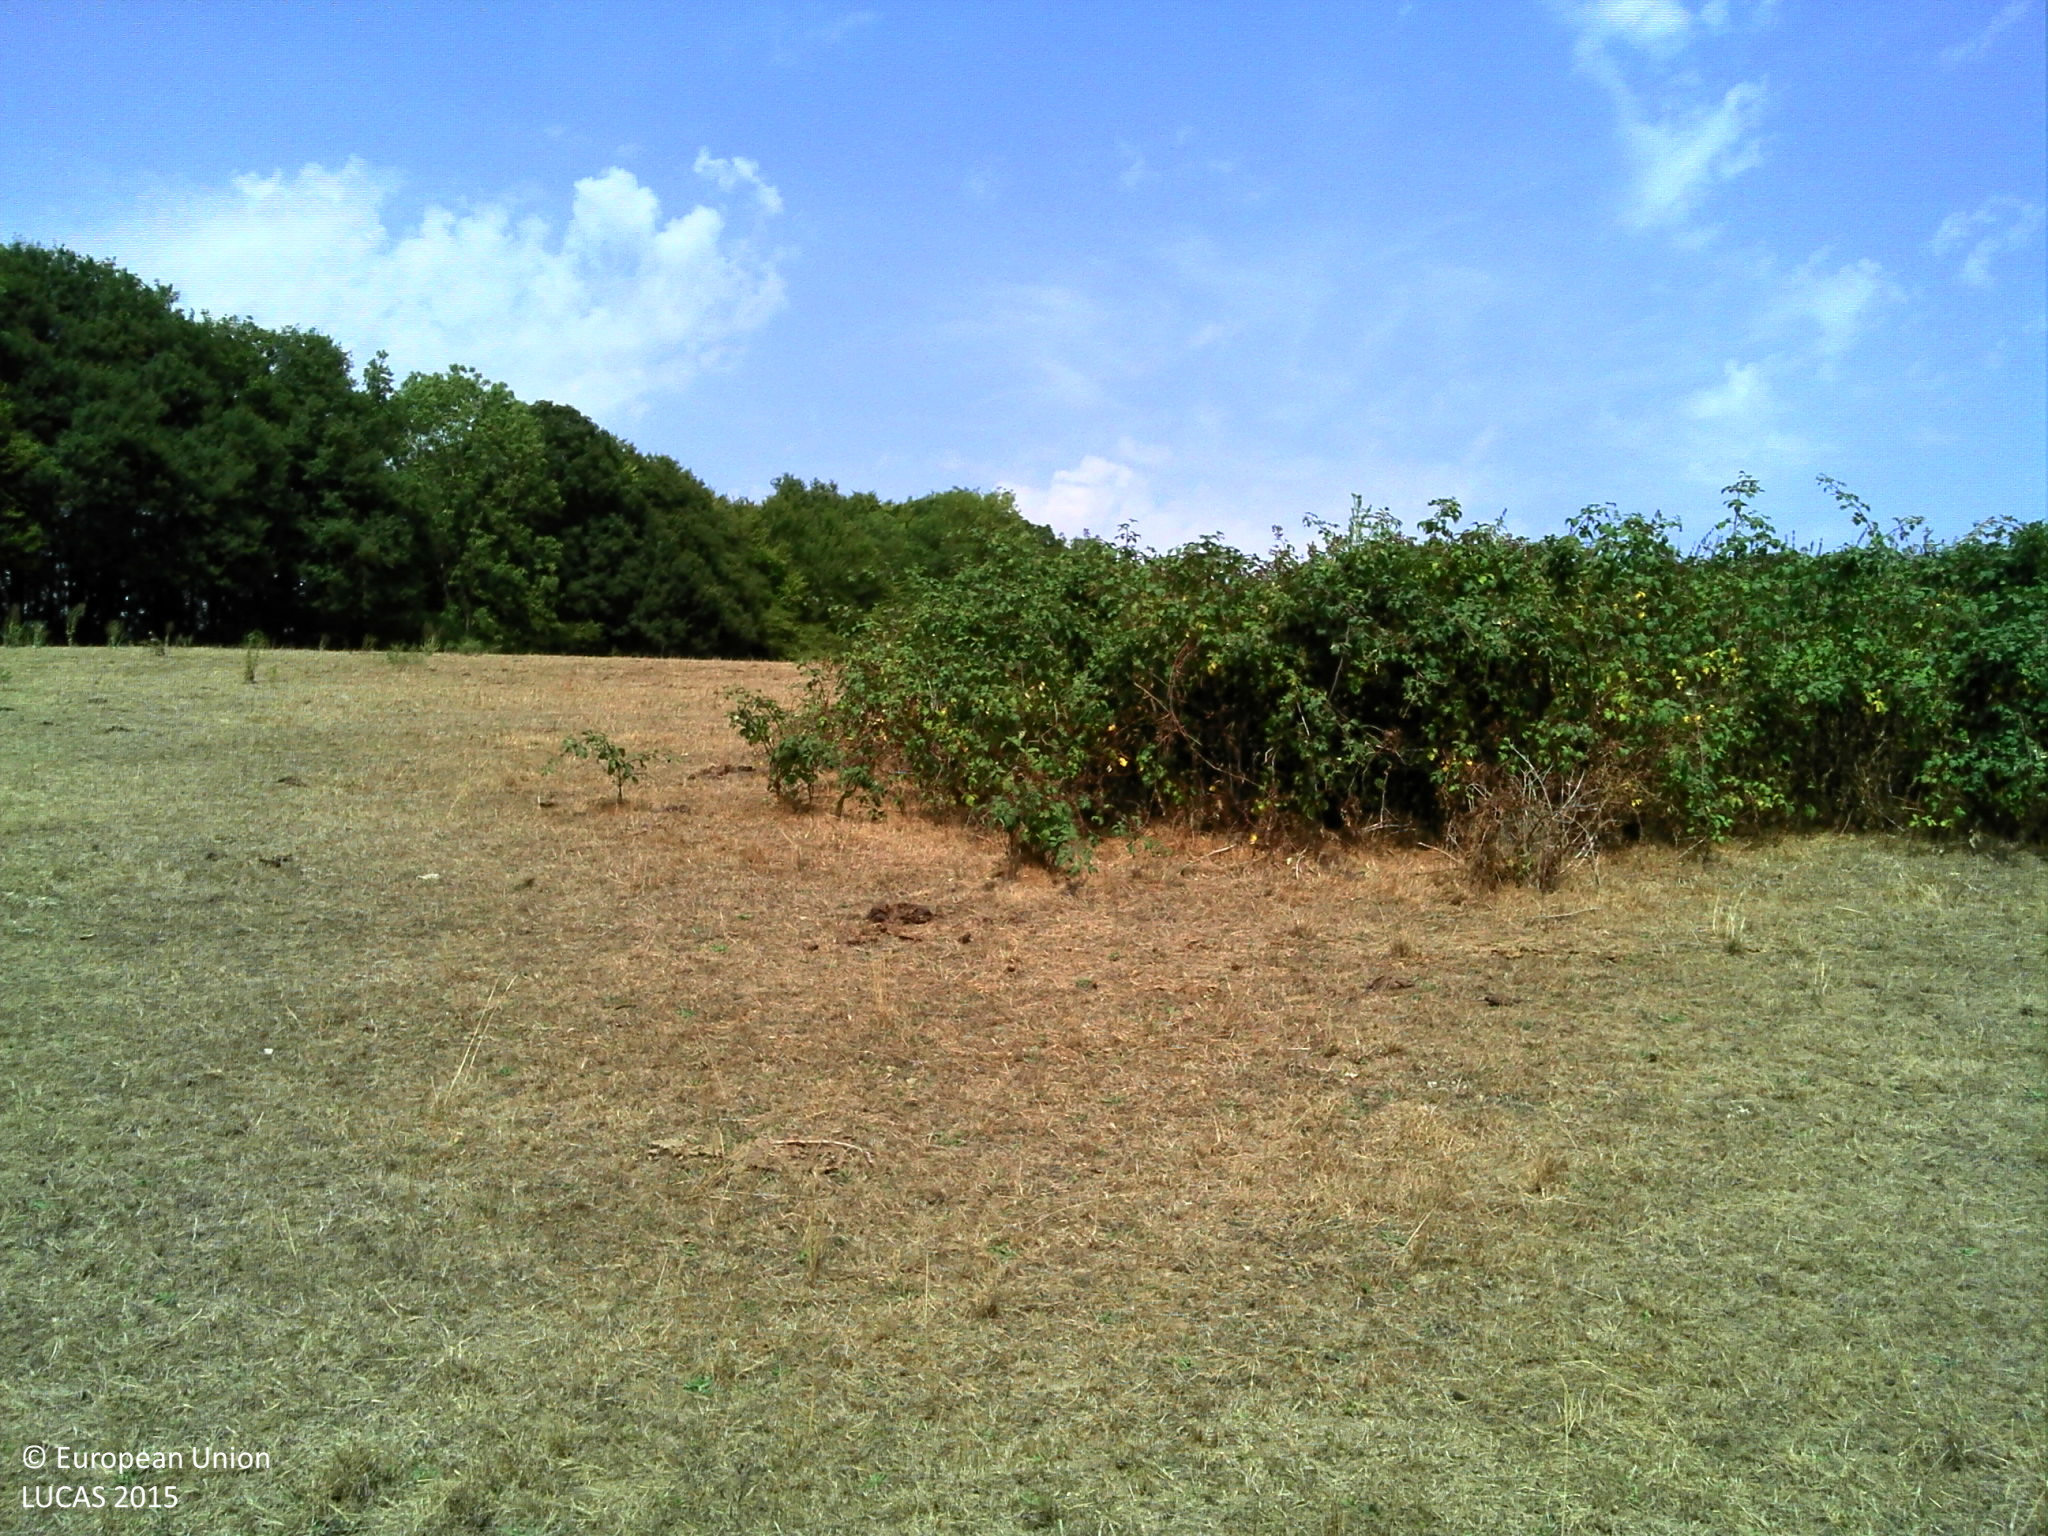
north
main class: Grassland
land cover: Grassland without tree/shrub cover
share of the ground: > 75 %
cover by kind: herbaceous plants 95 %, shrubs 5 %
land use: Agriculture (excluding fallow land and kitchen gardens)
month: August
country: FR
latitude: 47.7738
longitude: 3.1216
